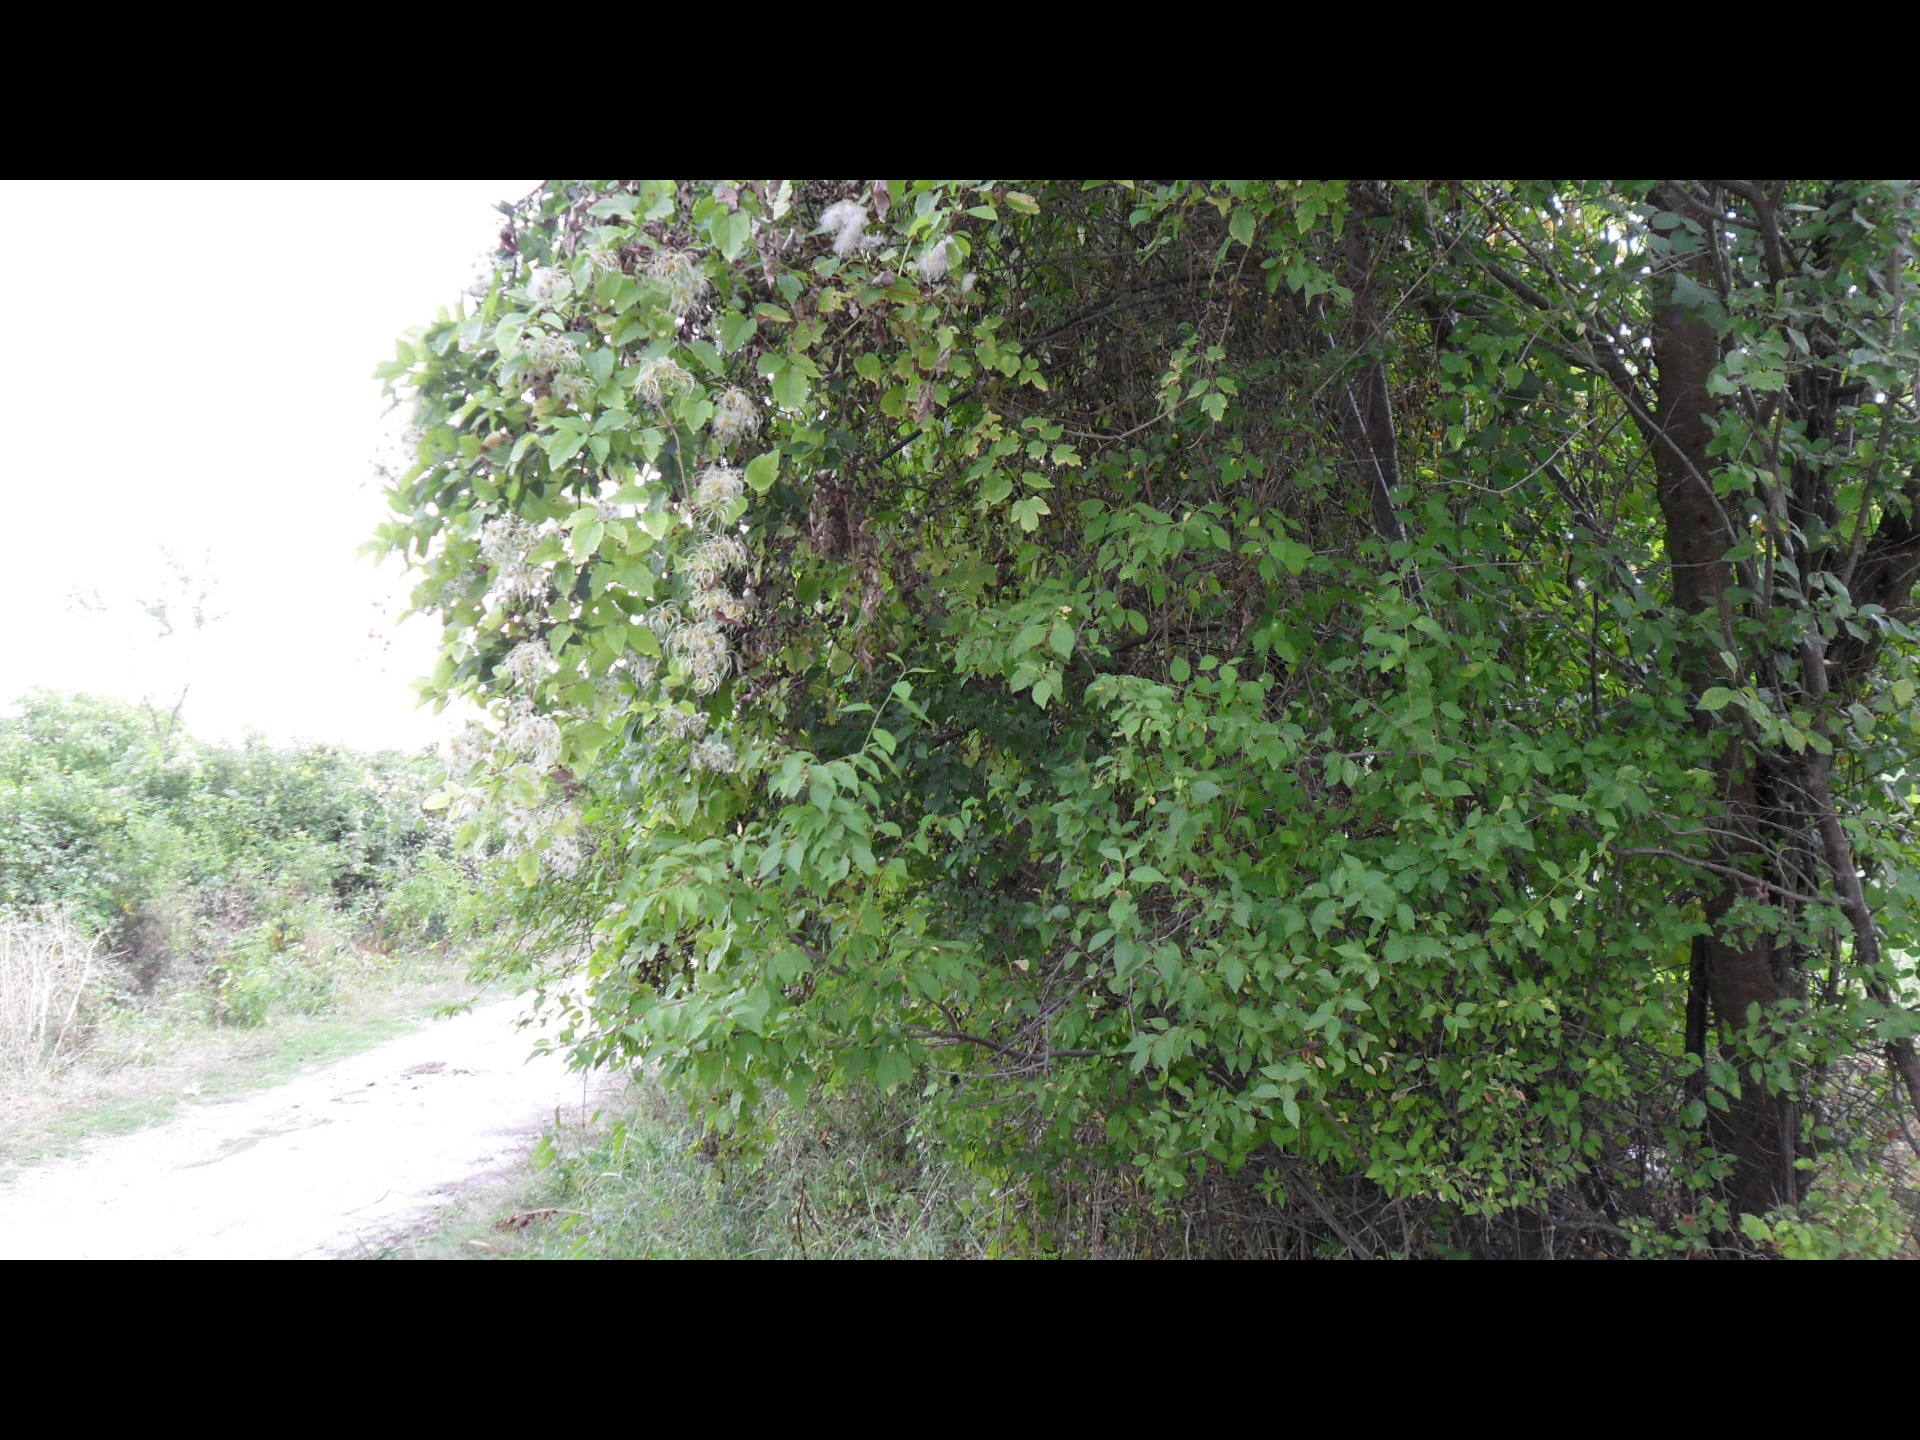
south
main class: Grassland
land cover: Grassland with sparse tree/shrub cover
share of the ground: > 75 %
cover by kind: herbaceous plants 90 %, broadleaved forest trees 5 %, shrubs 5 %
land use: Residential
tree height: < 5 m
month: August
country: BG
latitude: 43.3088
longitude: 26.4110
